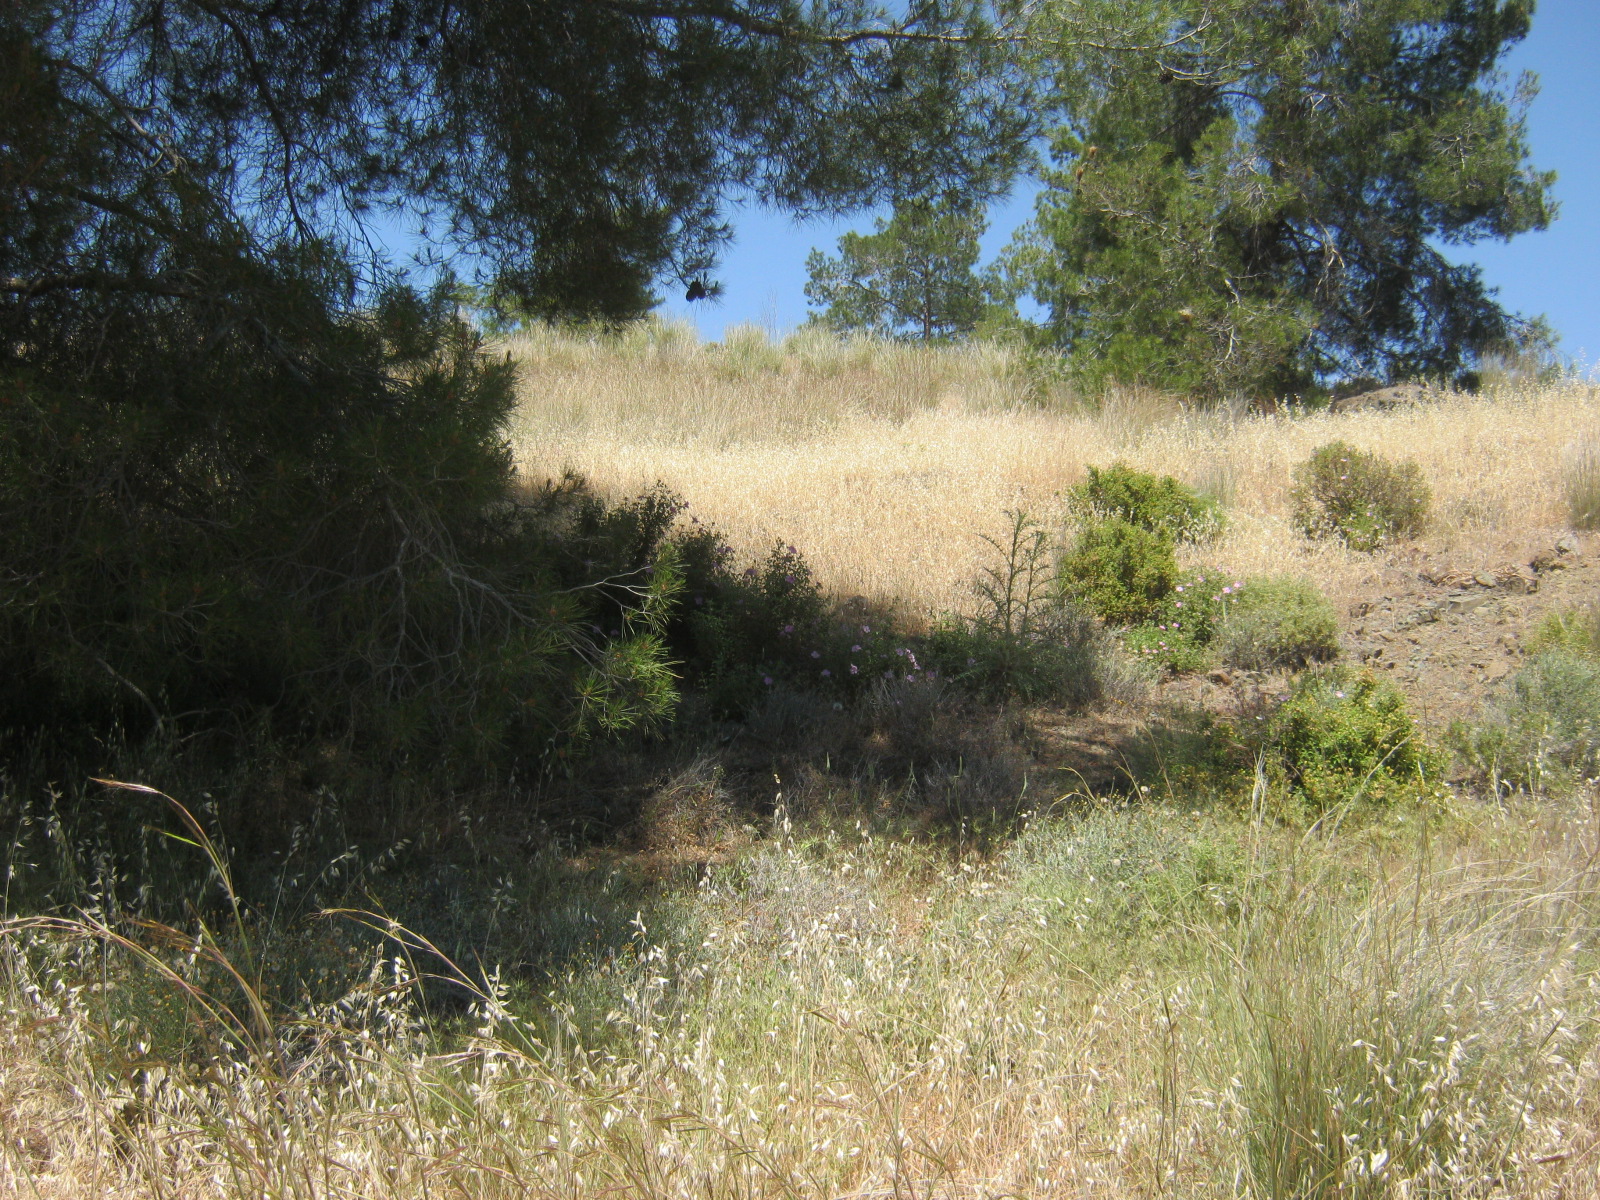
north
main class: Grassland
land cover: Grassland with sparse tree/shrub cover
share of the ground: > 75 %
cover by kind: herbaceous plants 80 %, unconsolidated bare surface 10 %, coniferous forest trees 5 %, shrubs 5 %
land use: Semi-natural and natural areas not in use
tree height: > 5 m
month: May
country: CY
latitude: 35.0044
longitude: 33.2034
